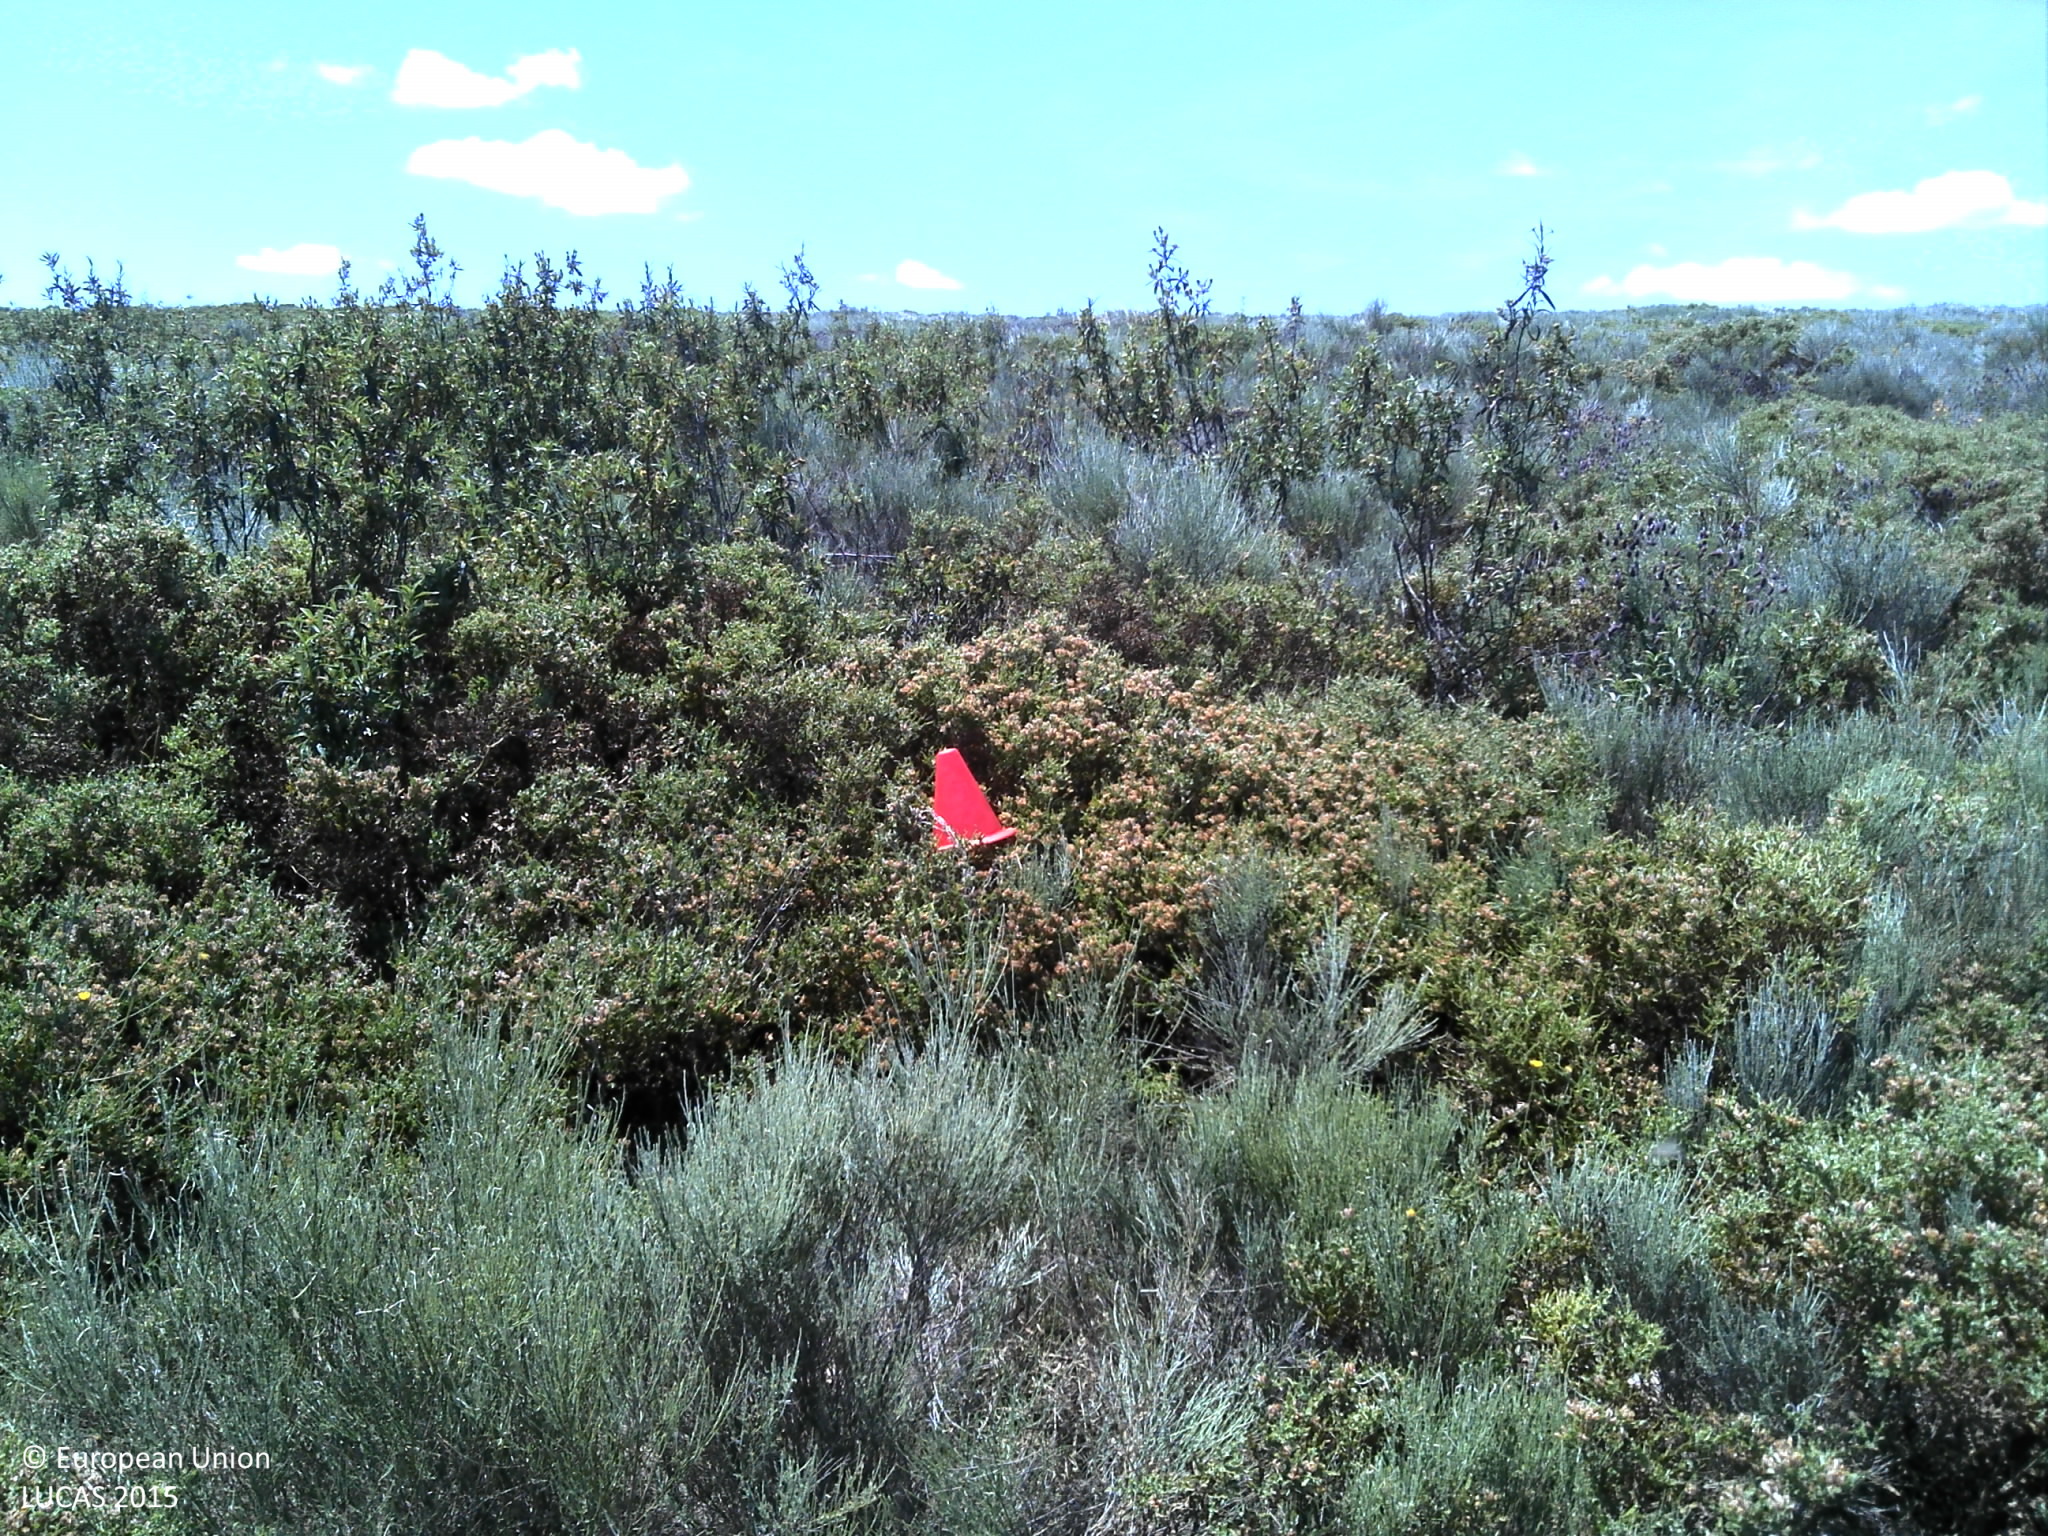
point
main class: Shrubland
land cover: Shrubland without tree cover
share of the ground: > 75 %
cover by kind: shrubs 80 %, unconsolidated bare surface 20 %
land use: Abandoned areas
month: May
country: PT
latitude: 41.1624
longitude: -6.9236
